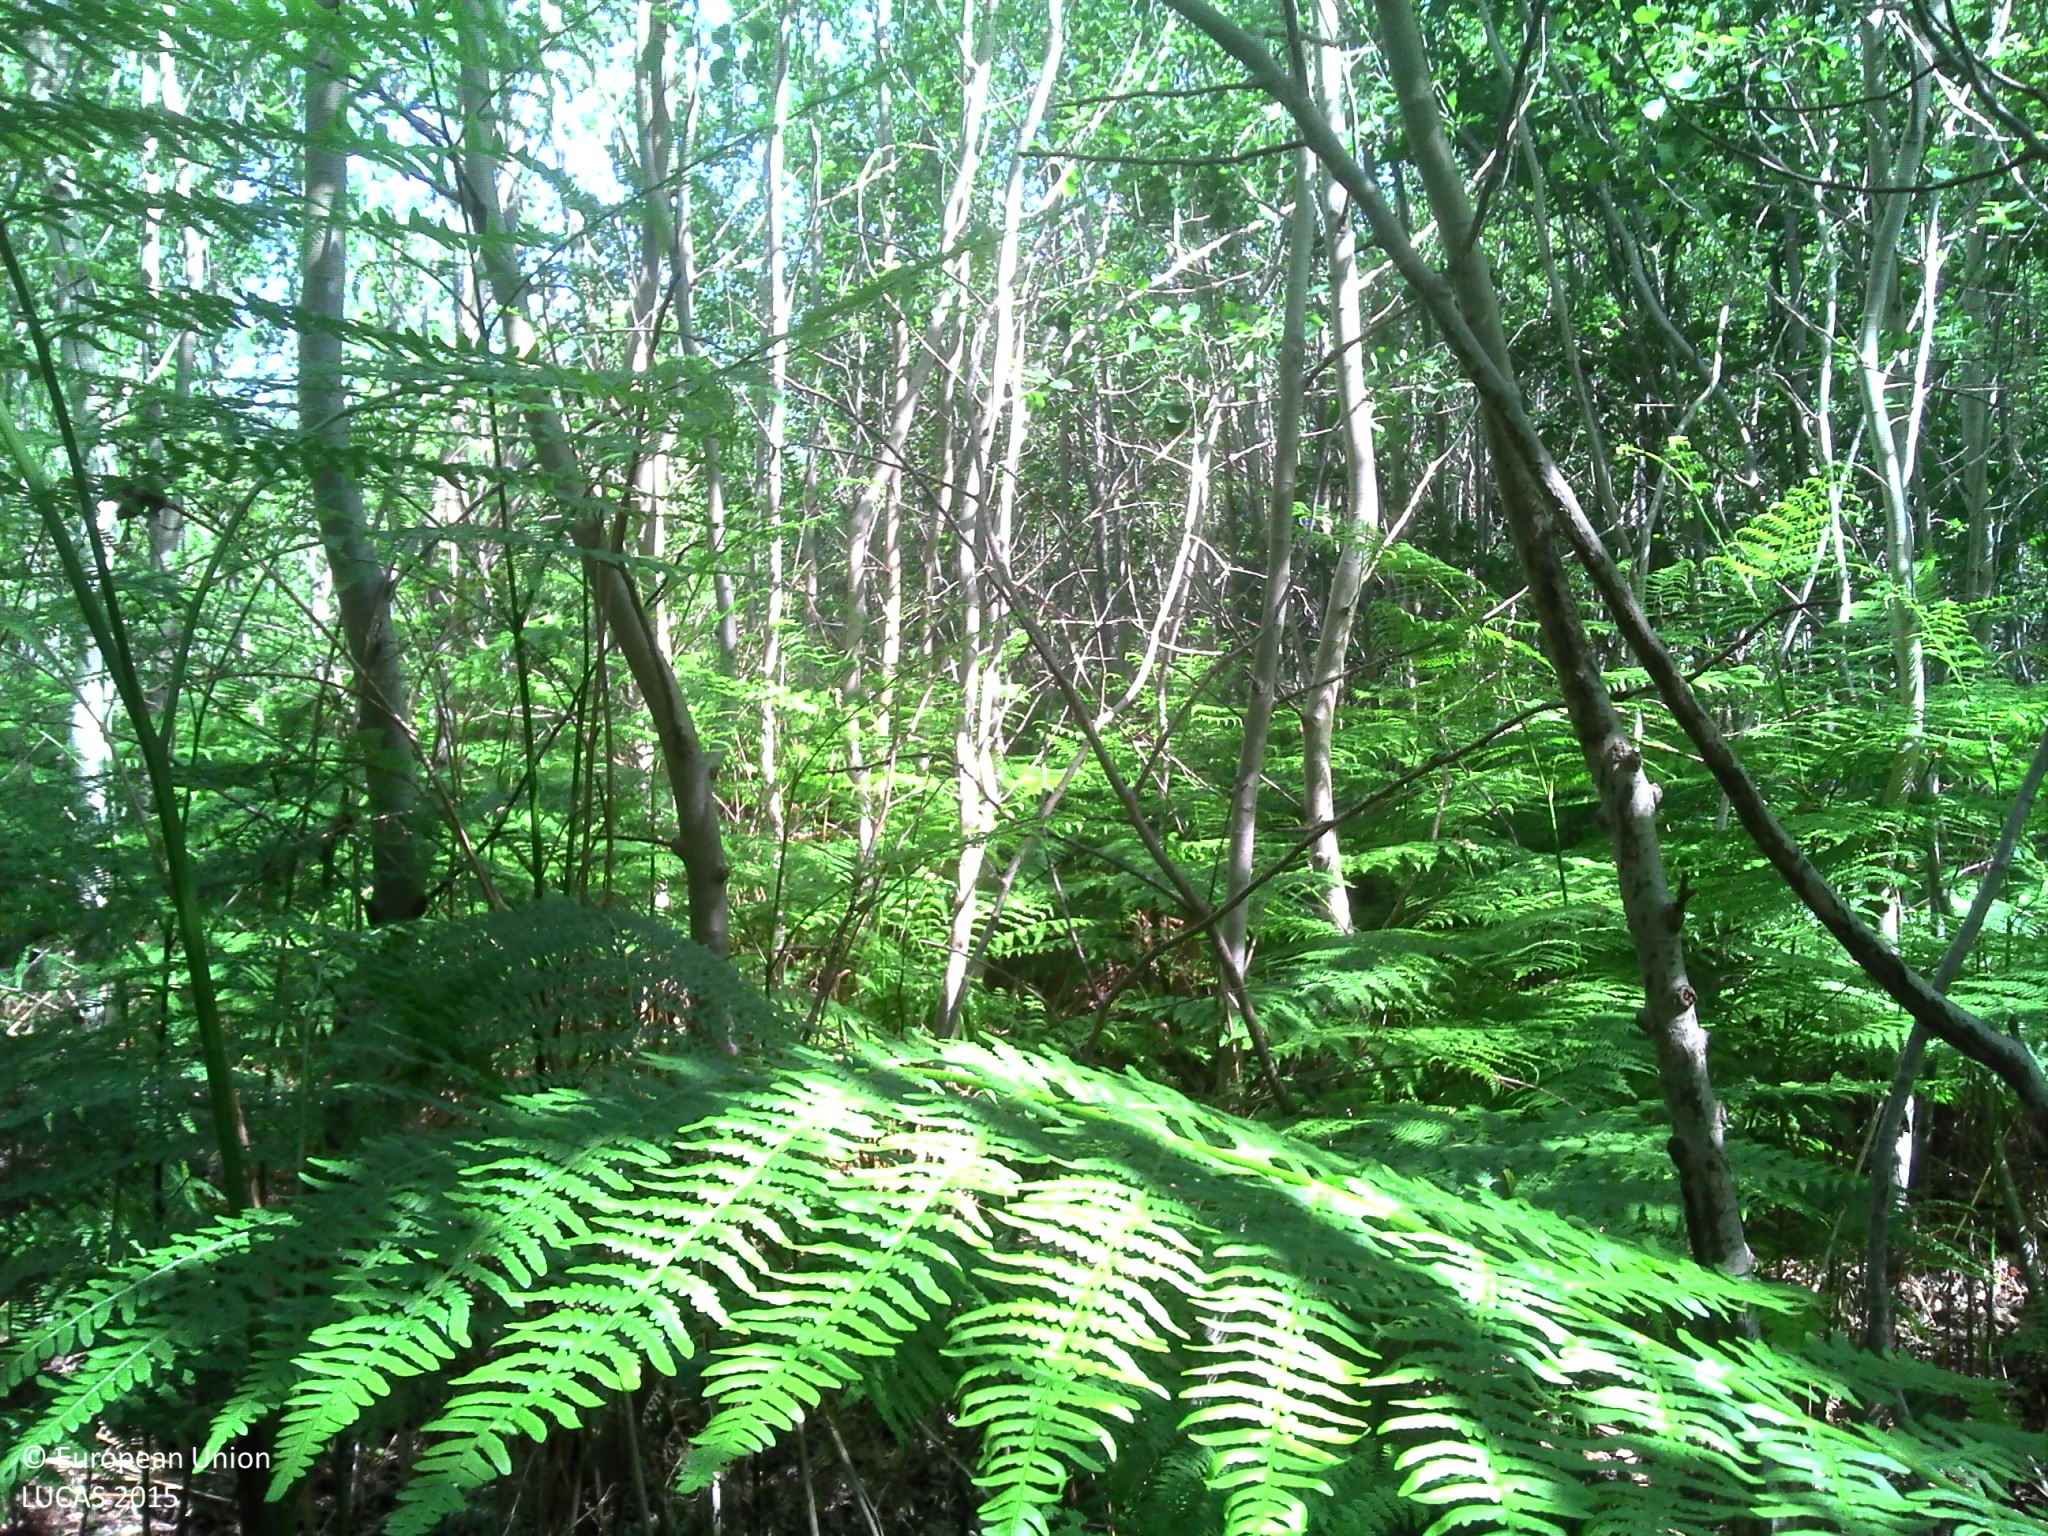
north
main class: Woodland
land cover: Broadleaved woodland
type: non-riverine alder, birch or aspen forest
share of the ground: > 75 %
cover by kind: broadleaved forest trees 80 %, herbaceous plants 20 %
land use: Forestry
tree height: > 5 m
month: June
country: FR
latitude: 47.3894
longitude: 0.0259
